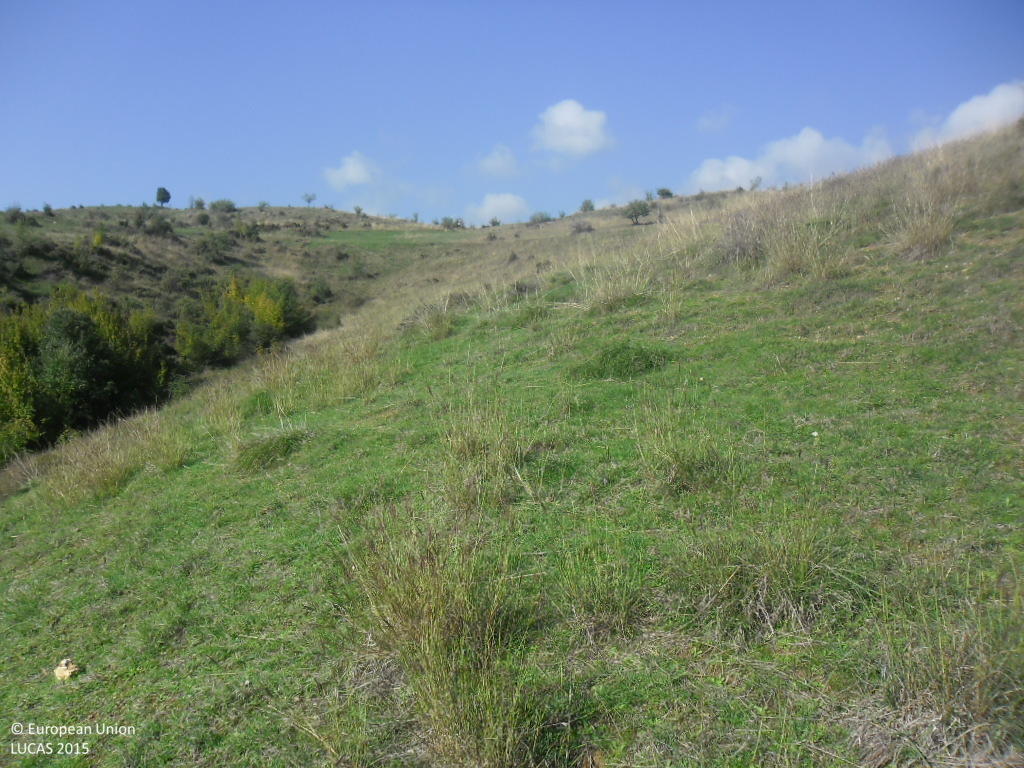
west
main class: Grassland
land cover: Grassland without tree/shrub cover
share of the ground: > 75 %
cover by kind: herbaceous plants 100 %
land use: Agriculture (excluding fallow land and kitchen gardens)
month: October
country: BG
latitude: 41.4600
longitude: 23.1767
